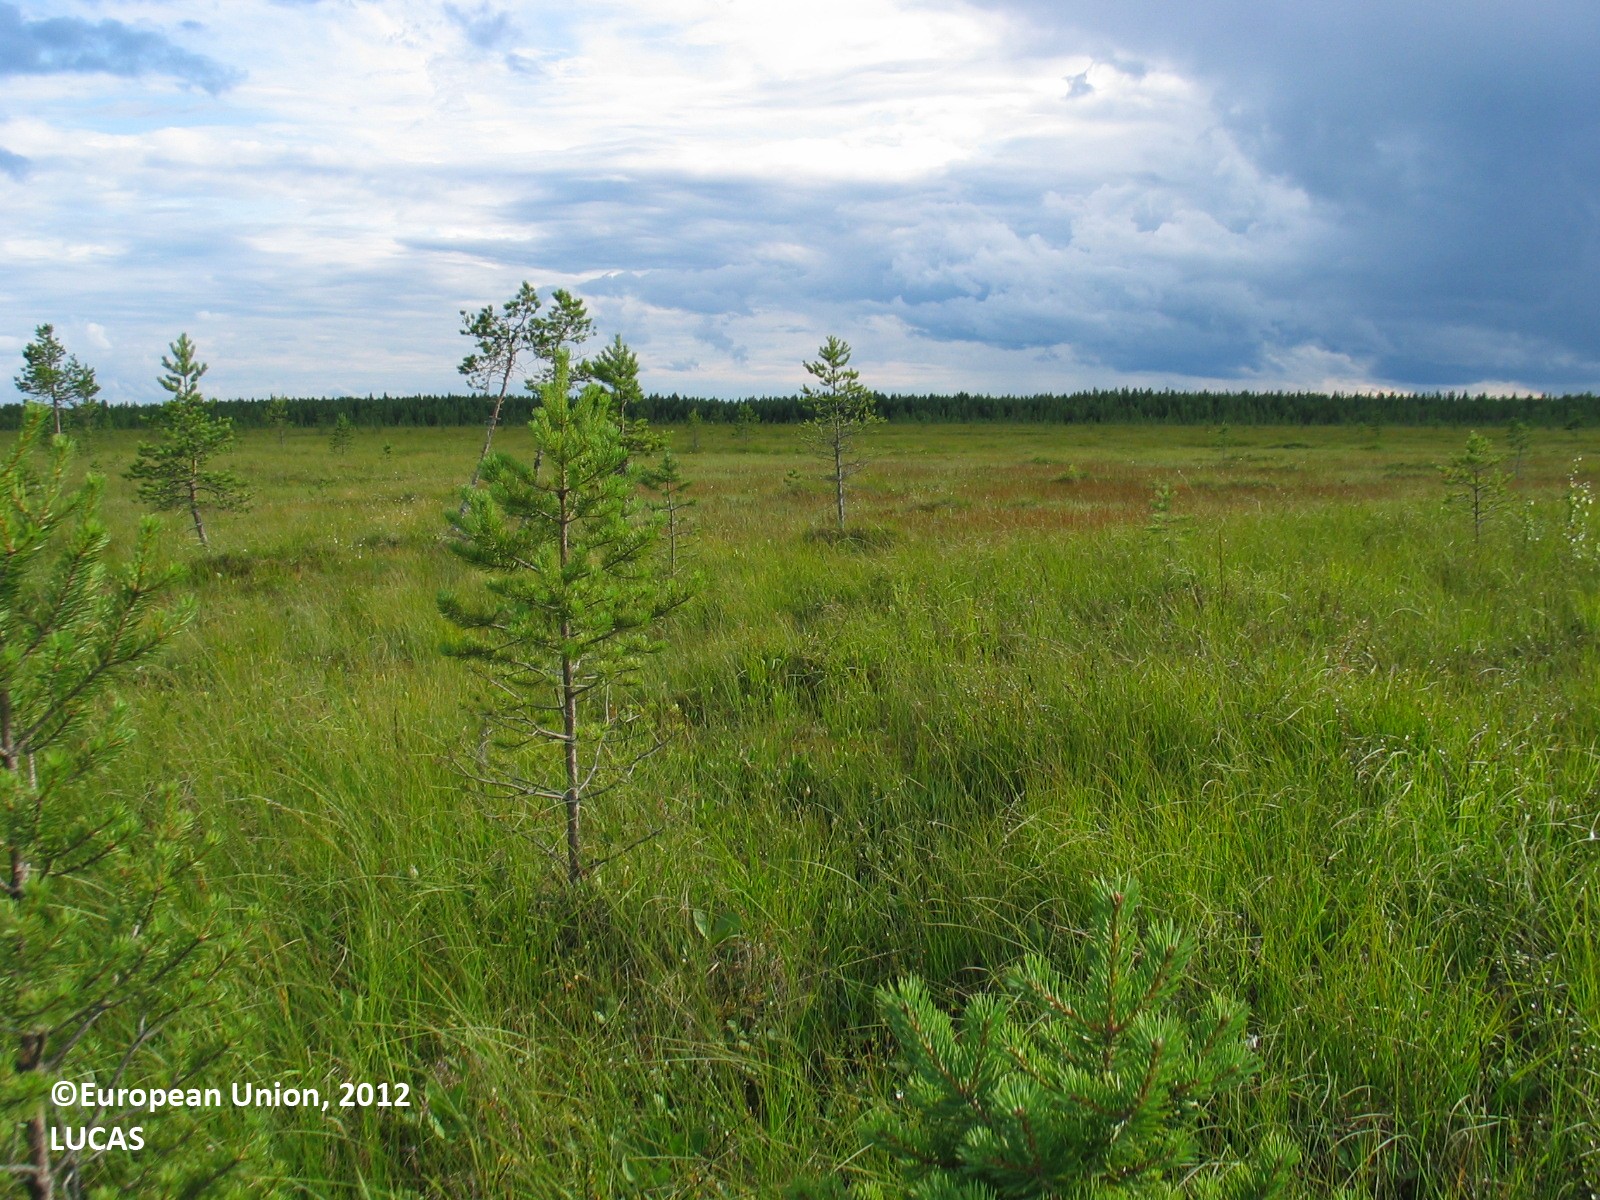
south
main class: Woodland
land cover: Pine dominated coniferous woodland
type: mire and swamp forests
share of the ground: 10 - 25 %
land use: Semi-natural and natural areas not in use
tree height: > 5 m
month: August
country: FI
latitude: 64.6102
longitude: 26.0504
